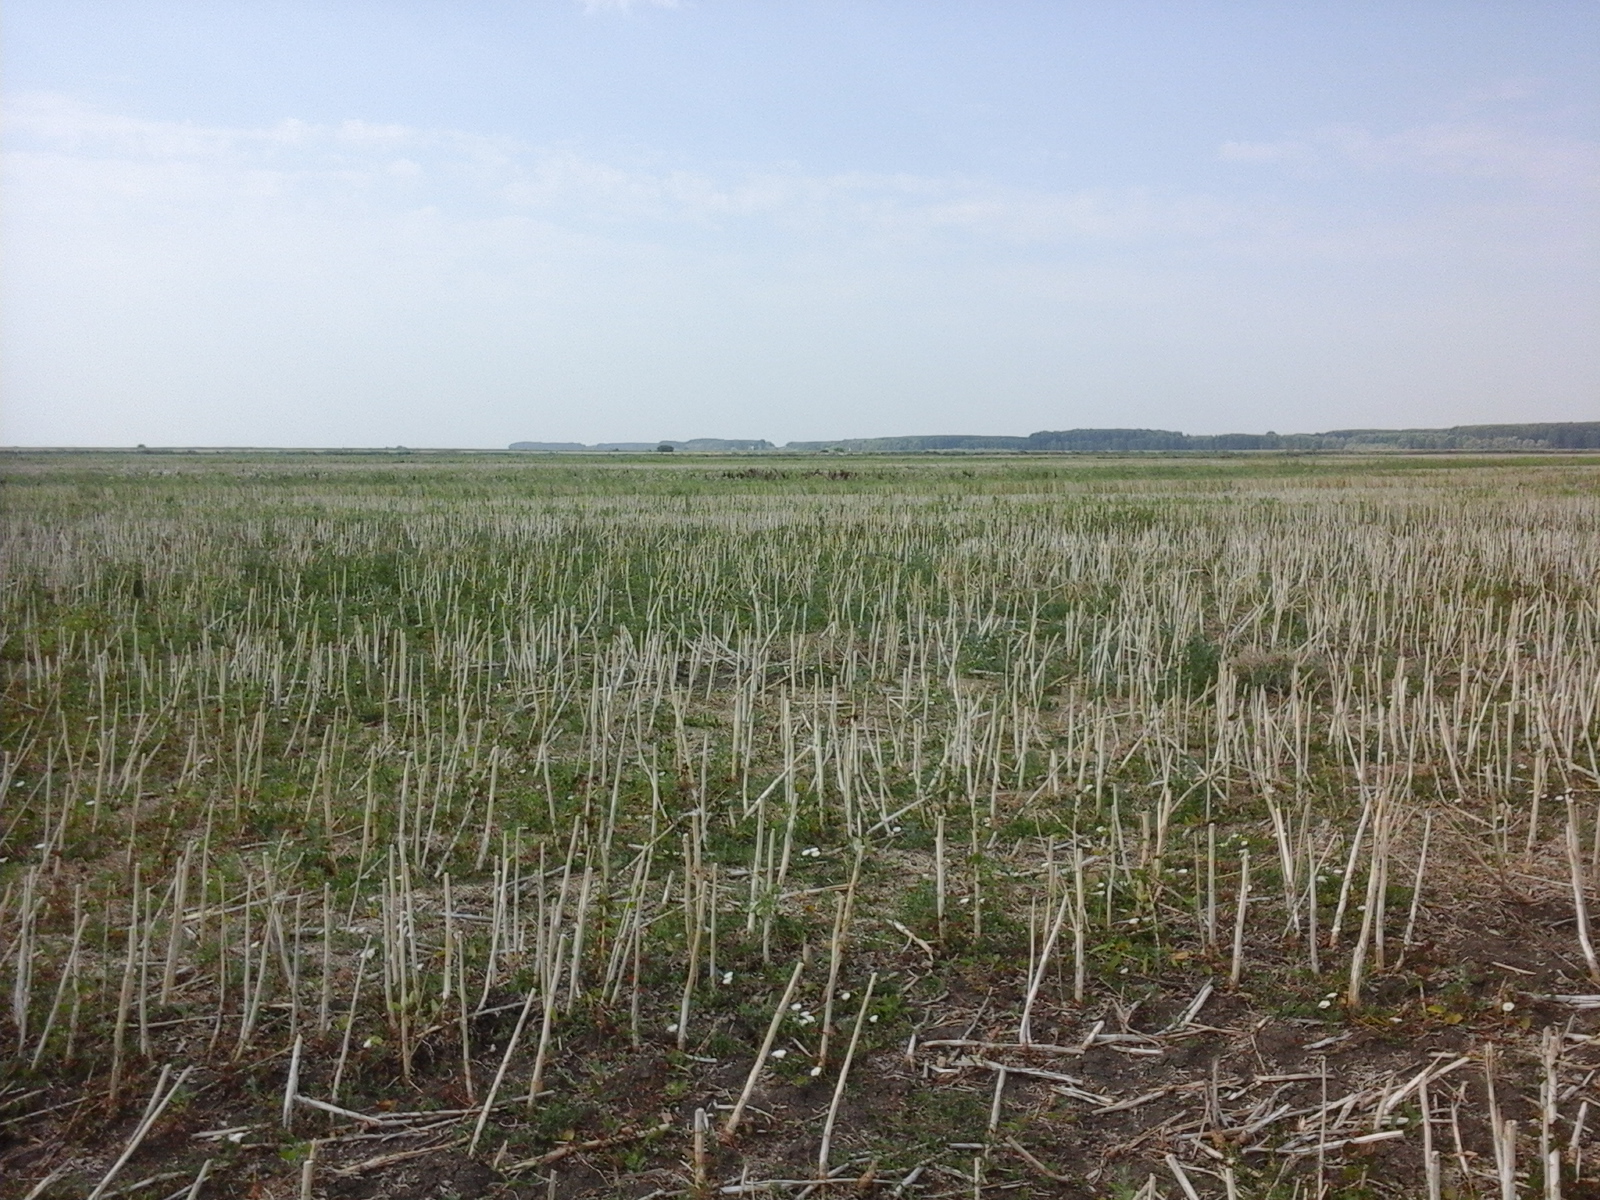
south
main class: Cropland
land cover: Rape and turnip rape
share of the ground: > 75 %
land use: Agriculture (excluding fallow land and kitchen gardens)
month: July
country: RO
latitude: 44.5024
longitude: 27.9536
